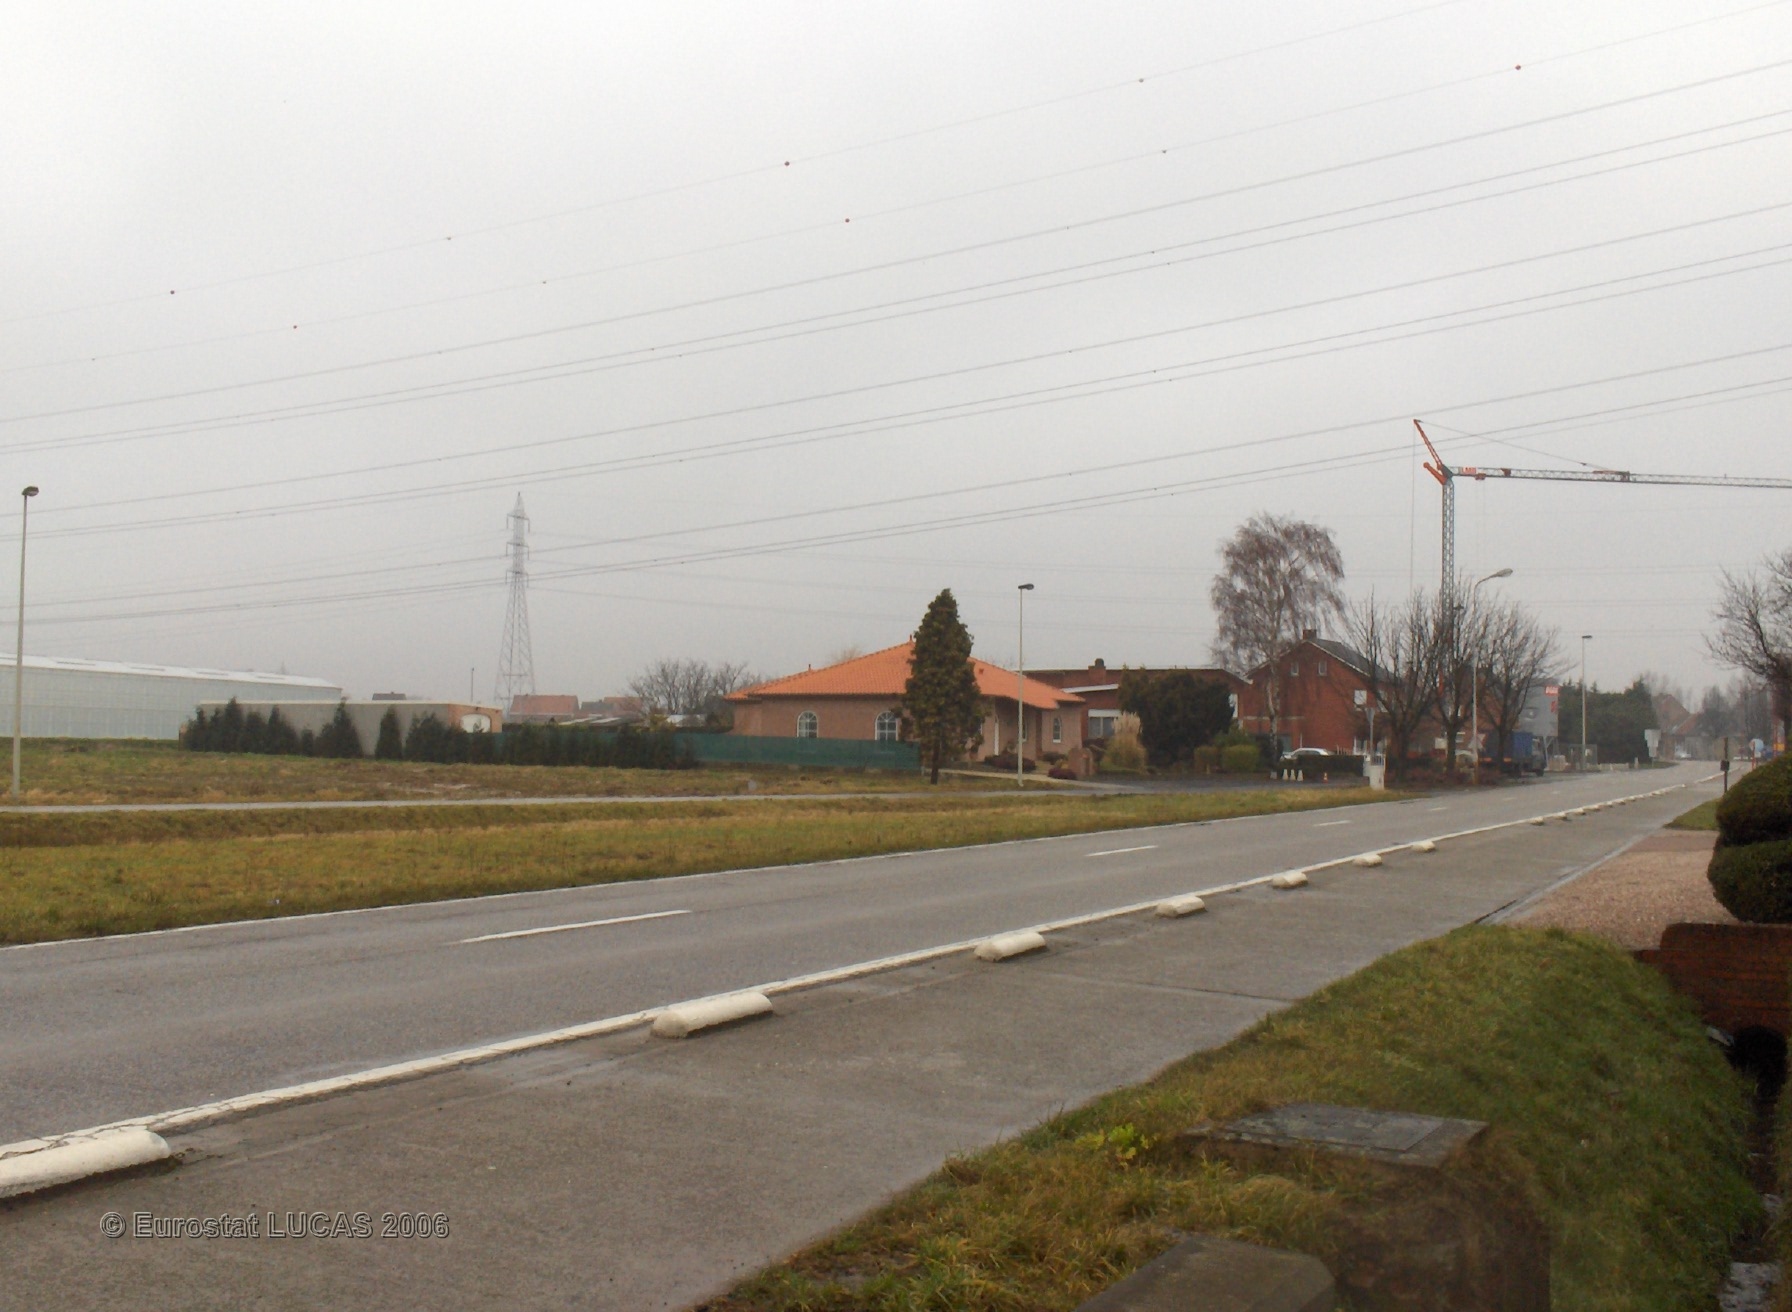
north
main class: Grassland
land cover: Grassland without tree/shrub cover
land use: Agriculture (excluding fallow land and kitchen gardens)
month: March
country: BE
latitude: 51.1147
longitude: 4.4960
